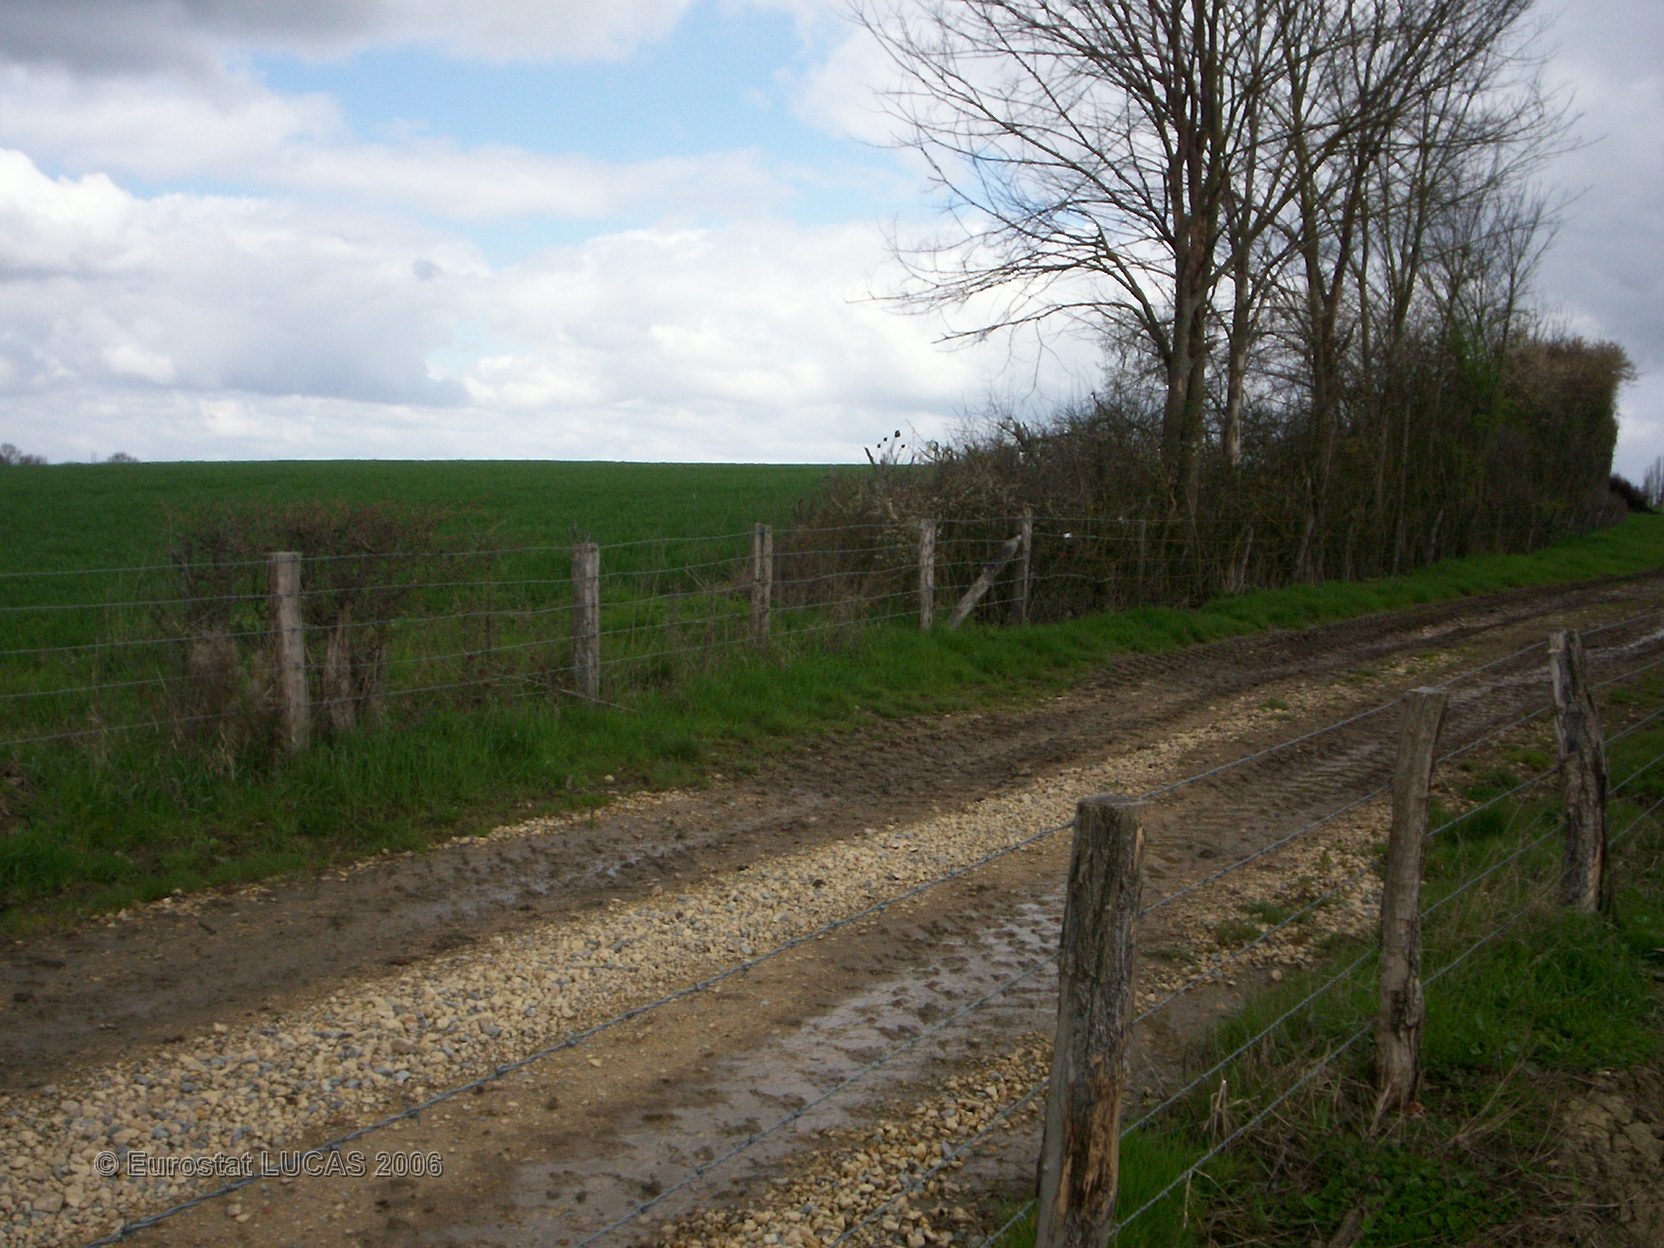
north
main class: Grassland
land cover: Grassland without tree/shrub cover
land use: Agriculture (excluding fallow land and kitchen gardens)
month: April
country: FR
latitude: 46.8698
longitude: 3.1088
